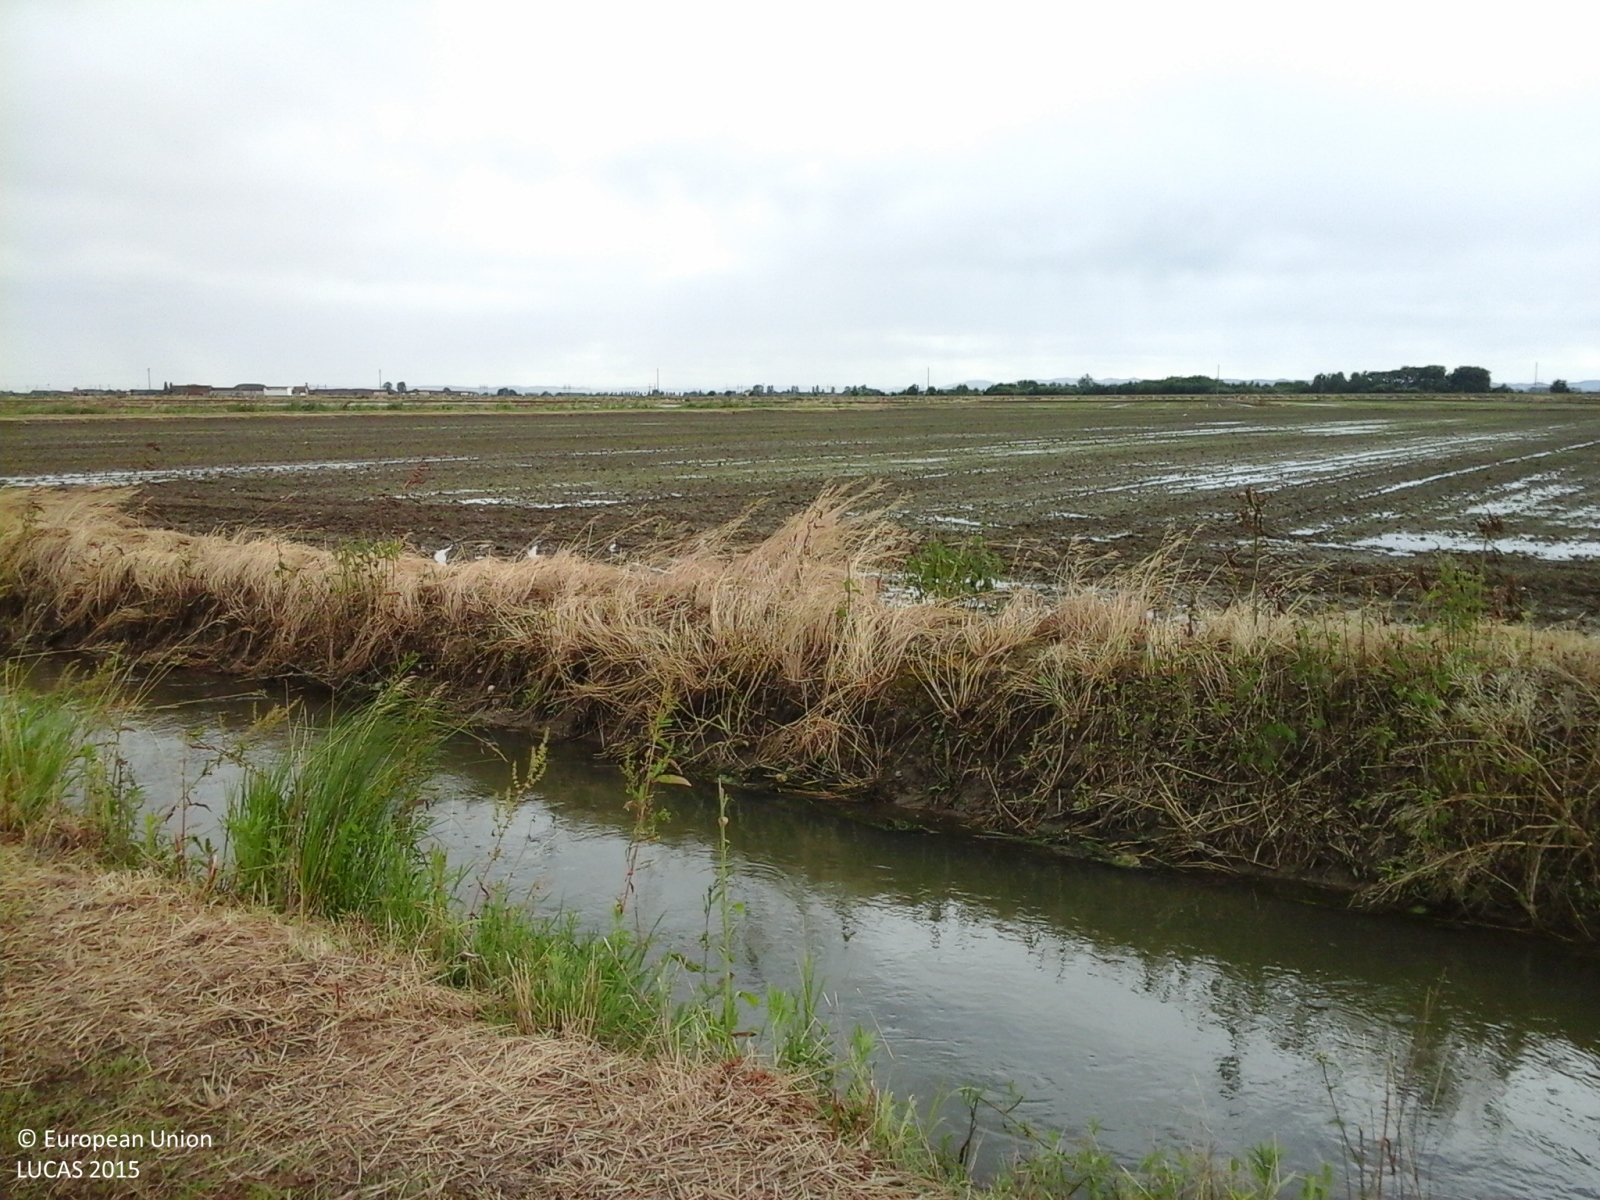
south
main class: Cropland
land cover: Rice
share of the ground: < 10 %
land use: Agriculture (excluding fallow land and kitchen gardens)
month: May
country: IT
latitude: 45.3470
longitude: 8.3309
